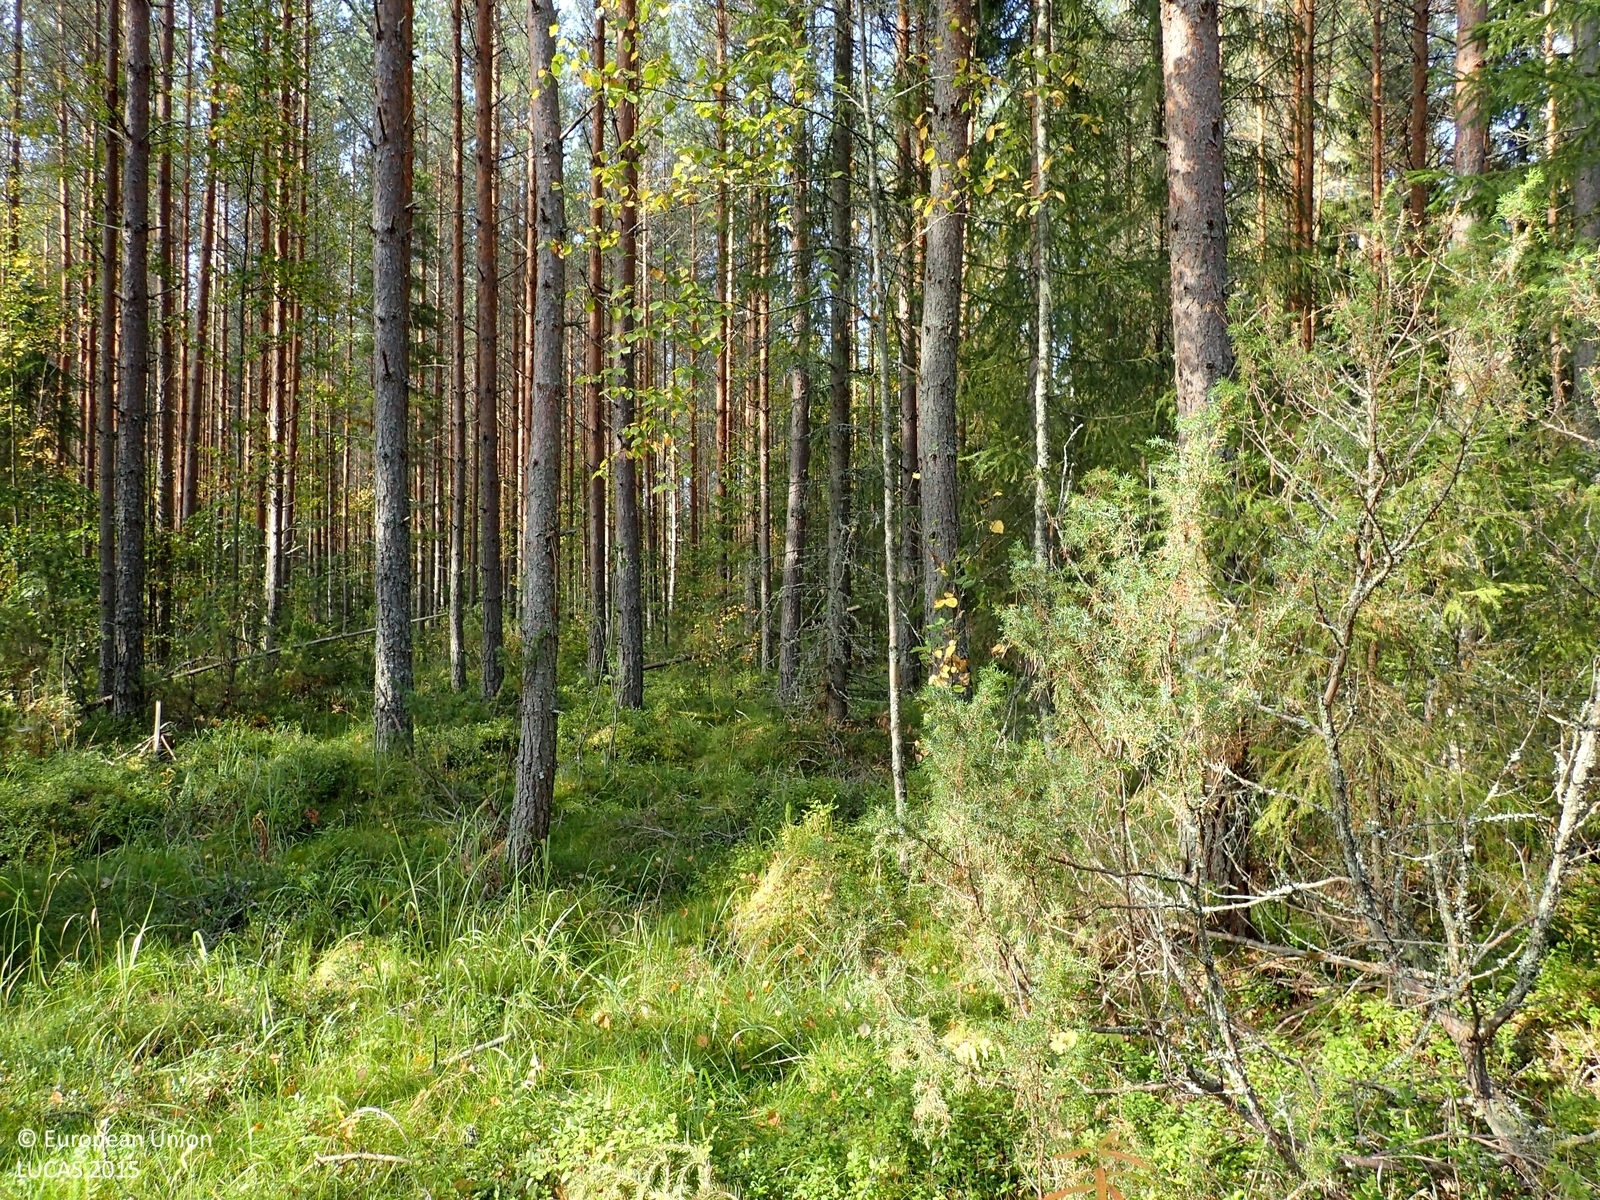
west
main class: Woodland
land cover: Other coniferous woodland
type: boreal forest
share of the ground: > 75 %
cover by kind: coniferous forest trees 65 %, shrubs 15 %, broadleaved forest trees 10 %, herbaceous plants 10 %
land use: Forestry
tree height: > 5 m
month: September
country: FI
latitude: 63.1701
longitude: 25.6585
